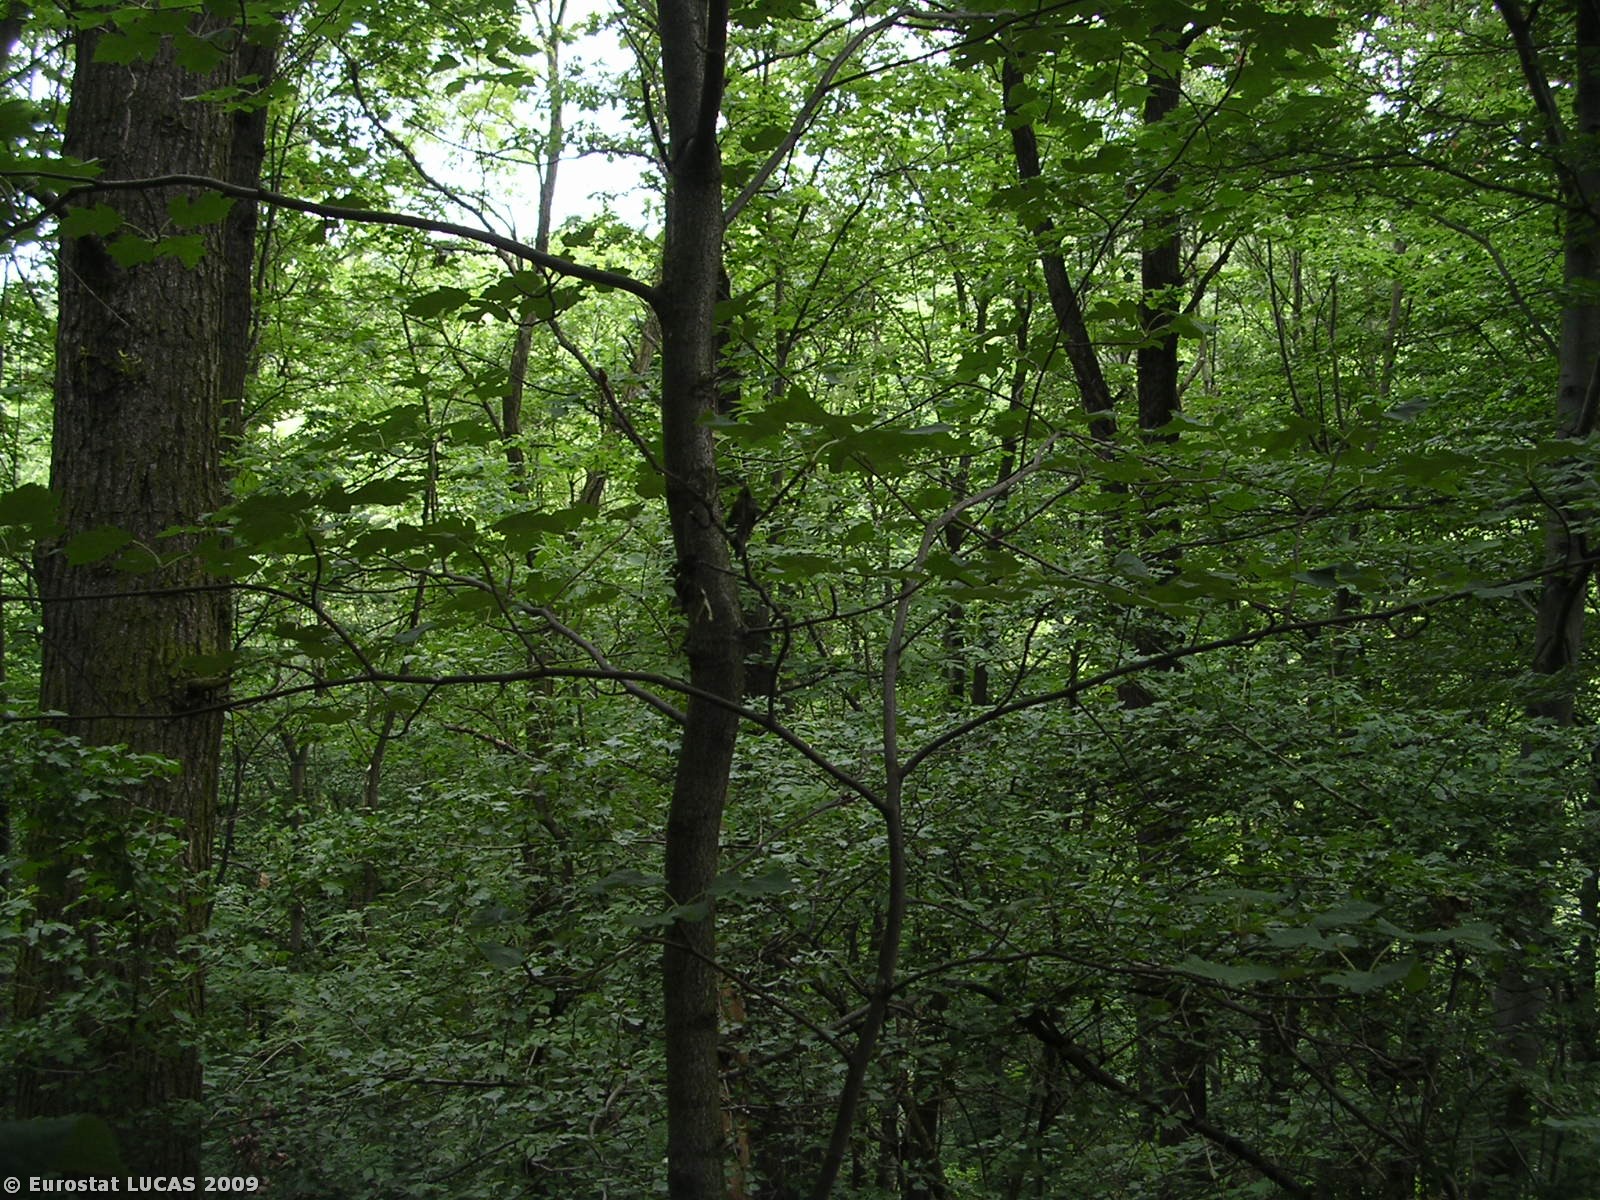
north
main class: Woodland
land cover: Broadleaved woodland
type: mesophytic deciduous forest
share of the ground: > 75 %
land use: Amenities, museums, leisure
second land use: Forestry
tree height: > 5 m
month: May
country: CZ
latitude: 50.1350
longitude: 14.4085
